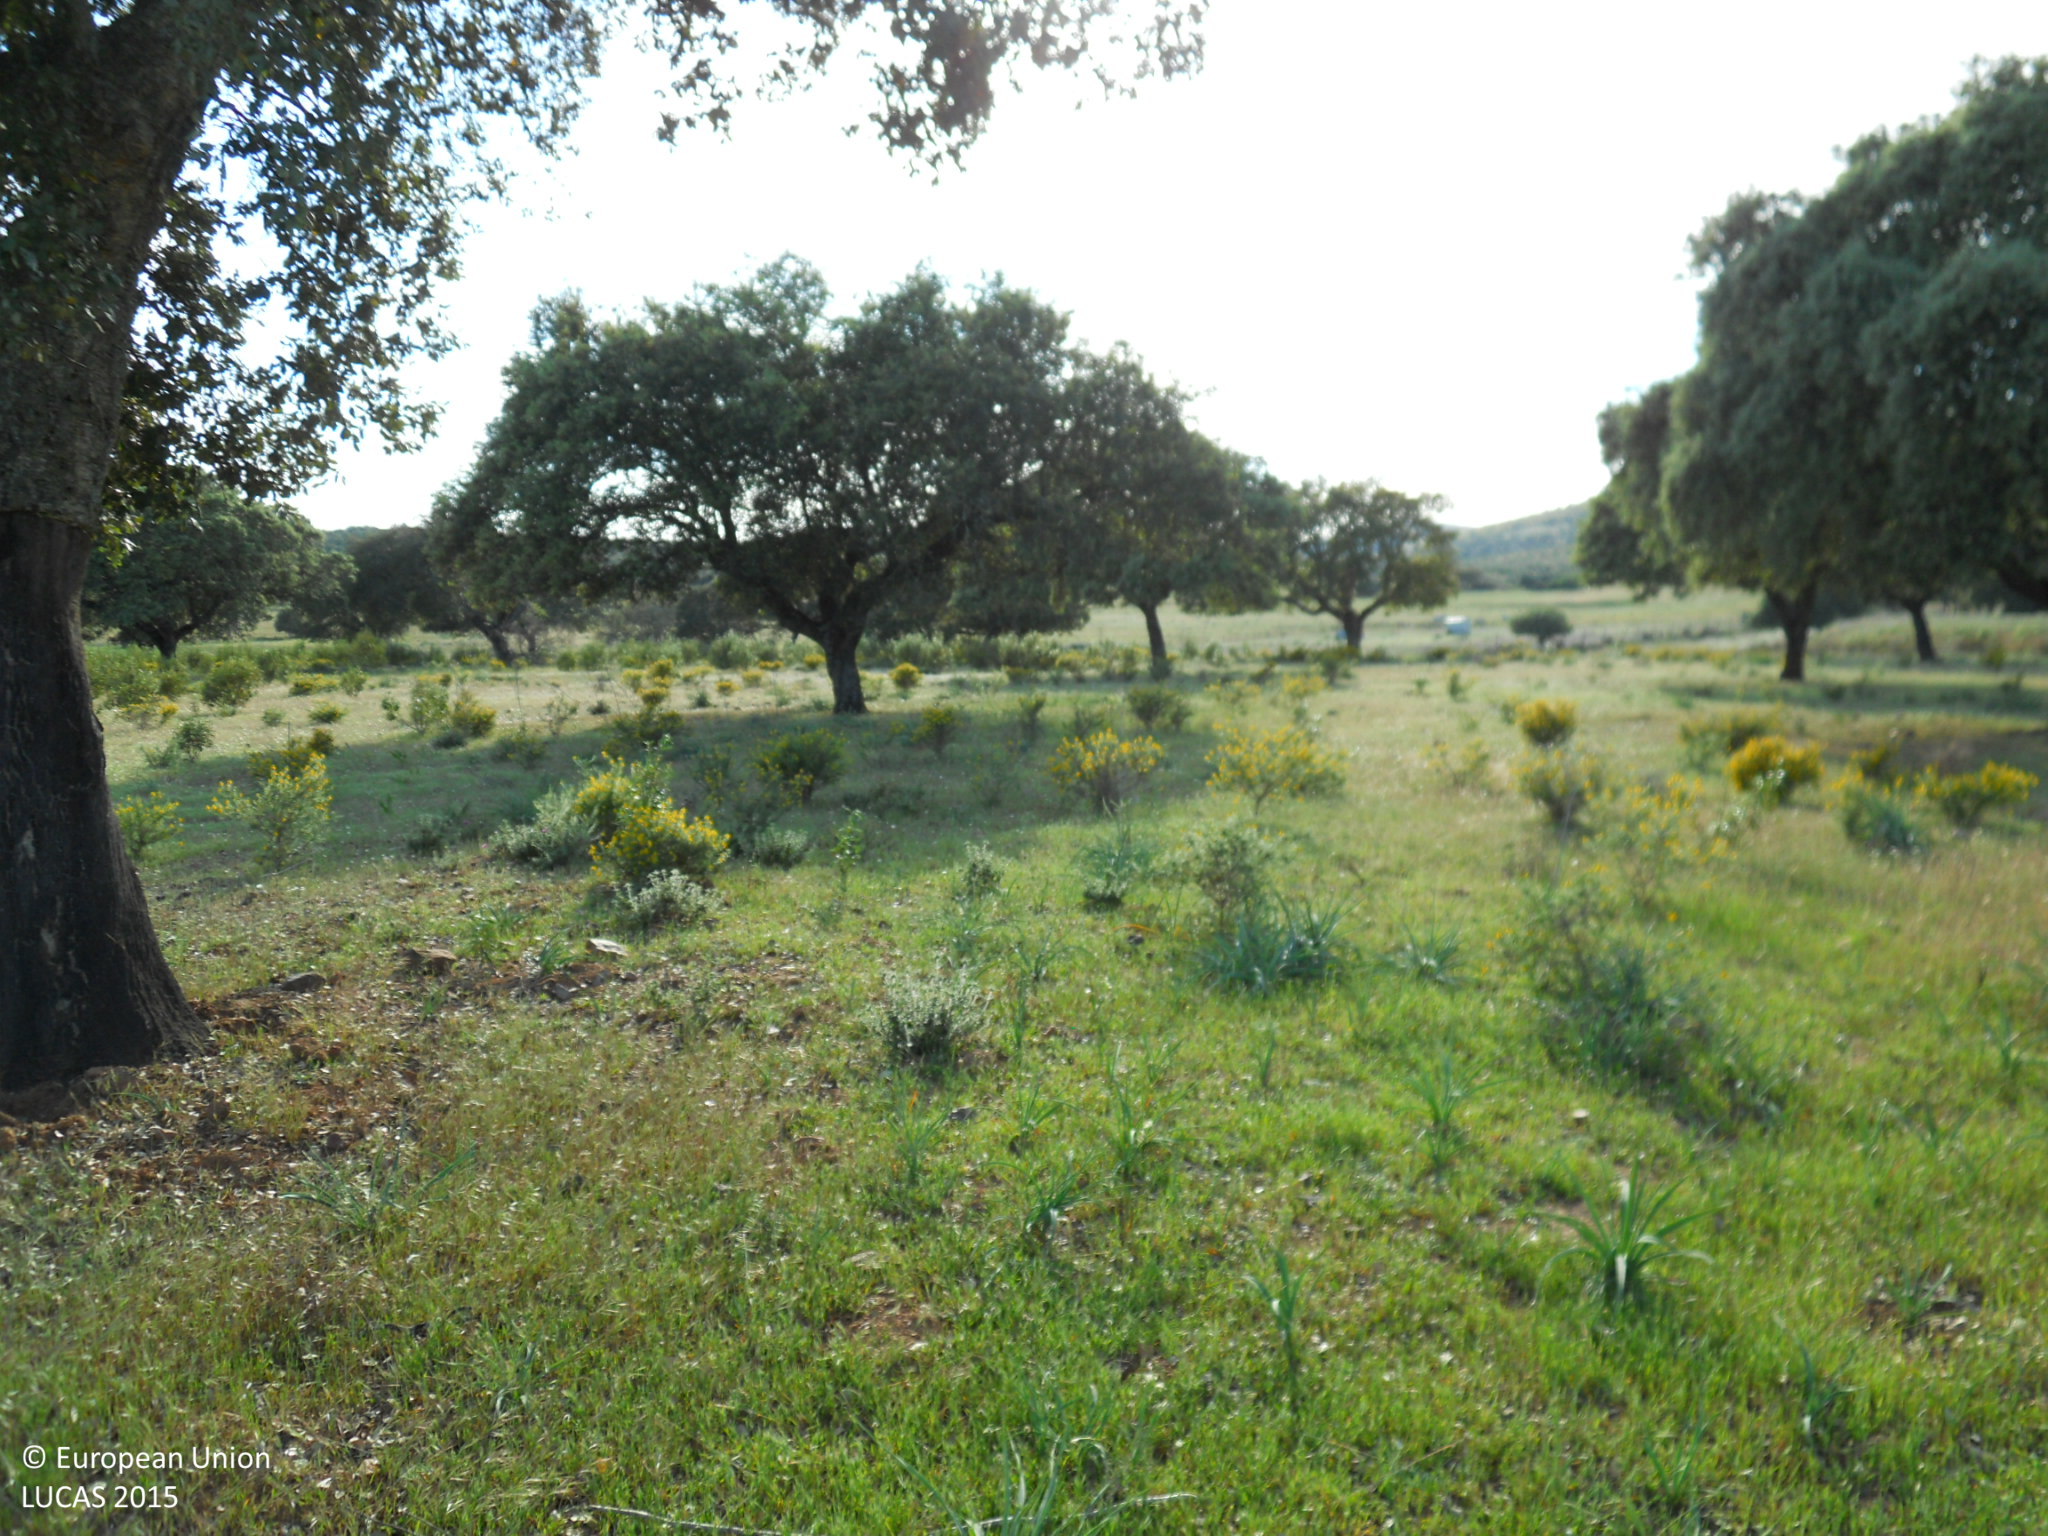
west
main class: Woodland
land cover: Broadleaved woodland
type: broadleaved evergreen forest
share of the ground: 50 - 75 %
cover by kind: broadleaved forest trees 70 %, herbaceous plants 20 %, shrubs 10 %
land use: Forestry
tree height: > 5 m
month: April
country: ES
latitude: 39.3562
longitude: -6.8214
